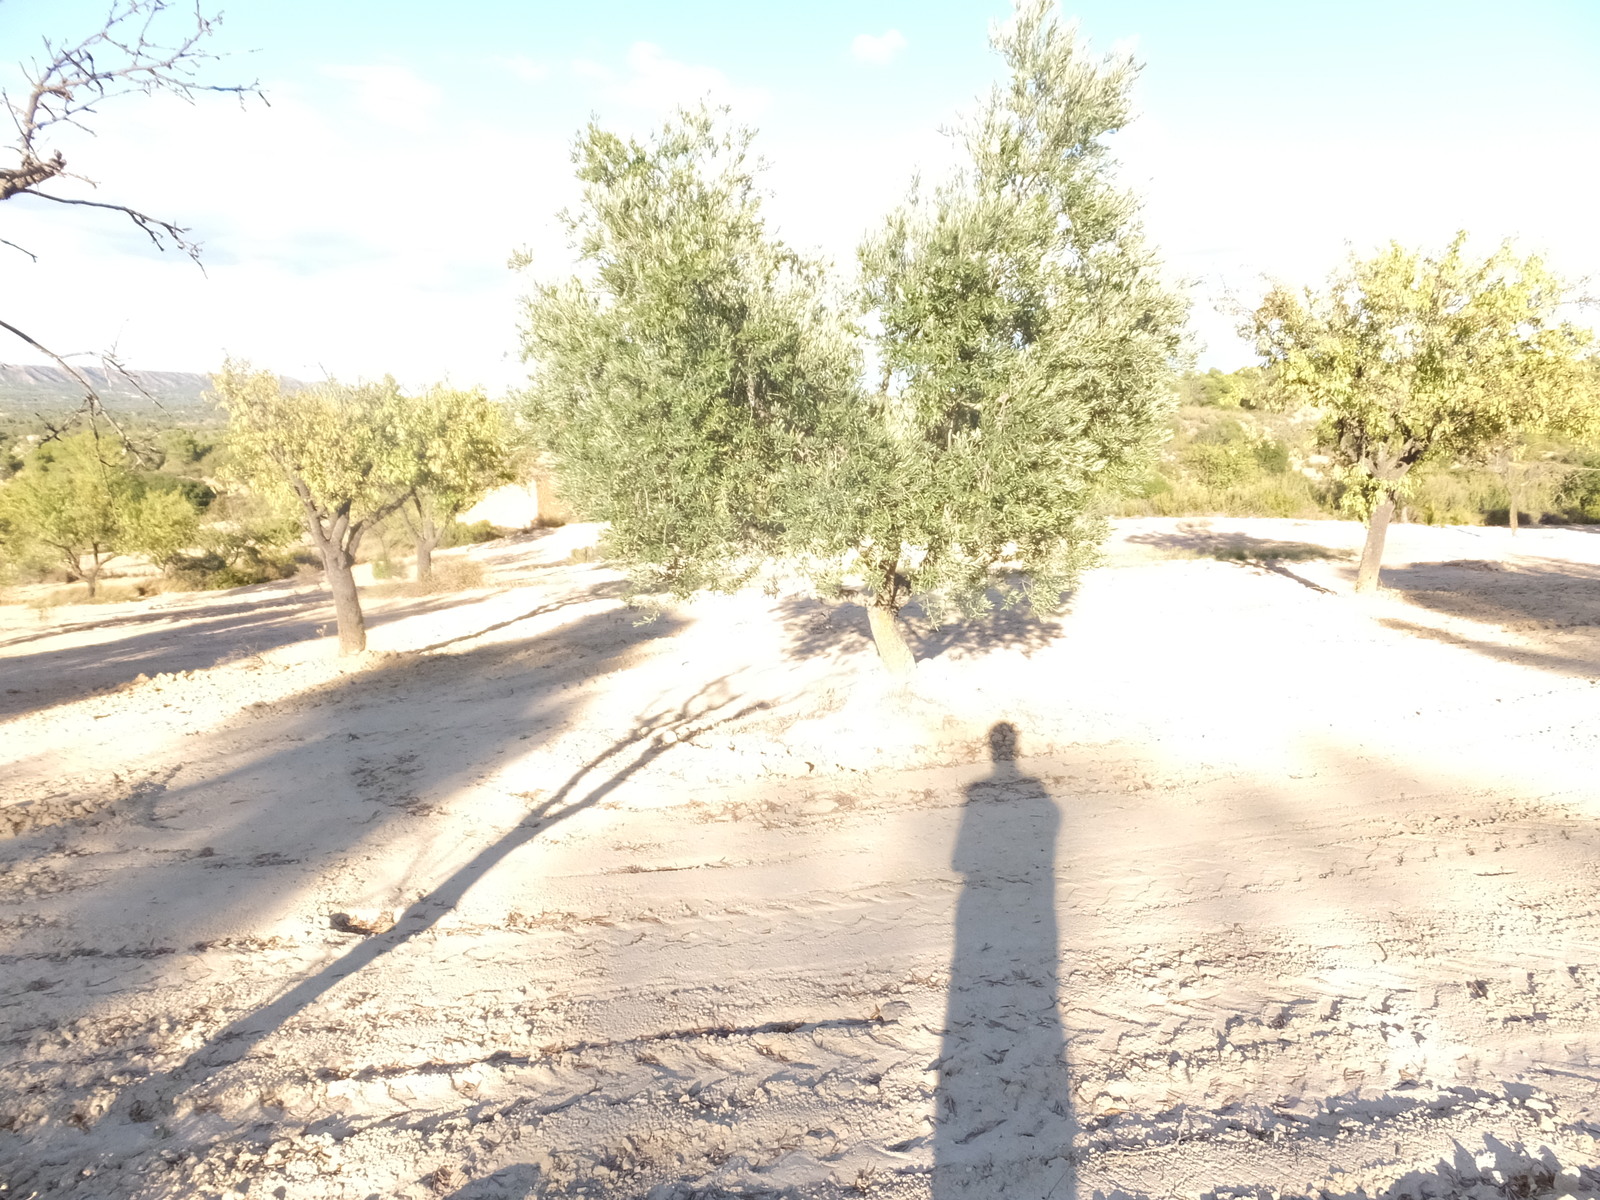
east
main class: Cropland
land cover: Nuts trees
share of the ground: 50 - 75 %
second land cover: Olive groves
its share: 25 - 50 %
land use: Agriculture (excluding fallow land and kitchen gardens)
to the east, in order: Nuts trees; Olive groves; Shrubland without tree cover; Nuts trees; Shruby margins; Olive groves; Pine dominated mixed woodland; Olive groves; Grass margins; Tracks; Shrubland with sparse tree cover; Tracks
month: August
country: ES
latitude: 41.2672
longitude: 0.1883
